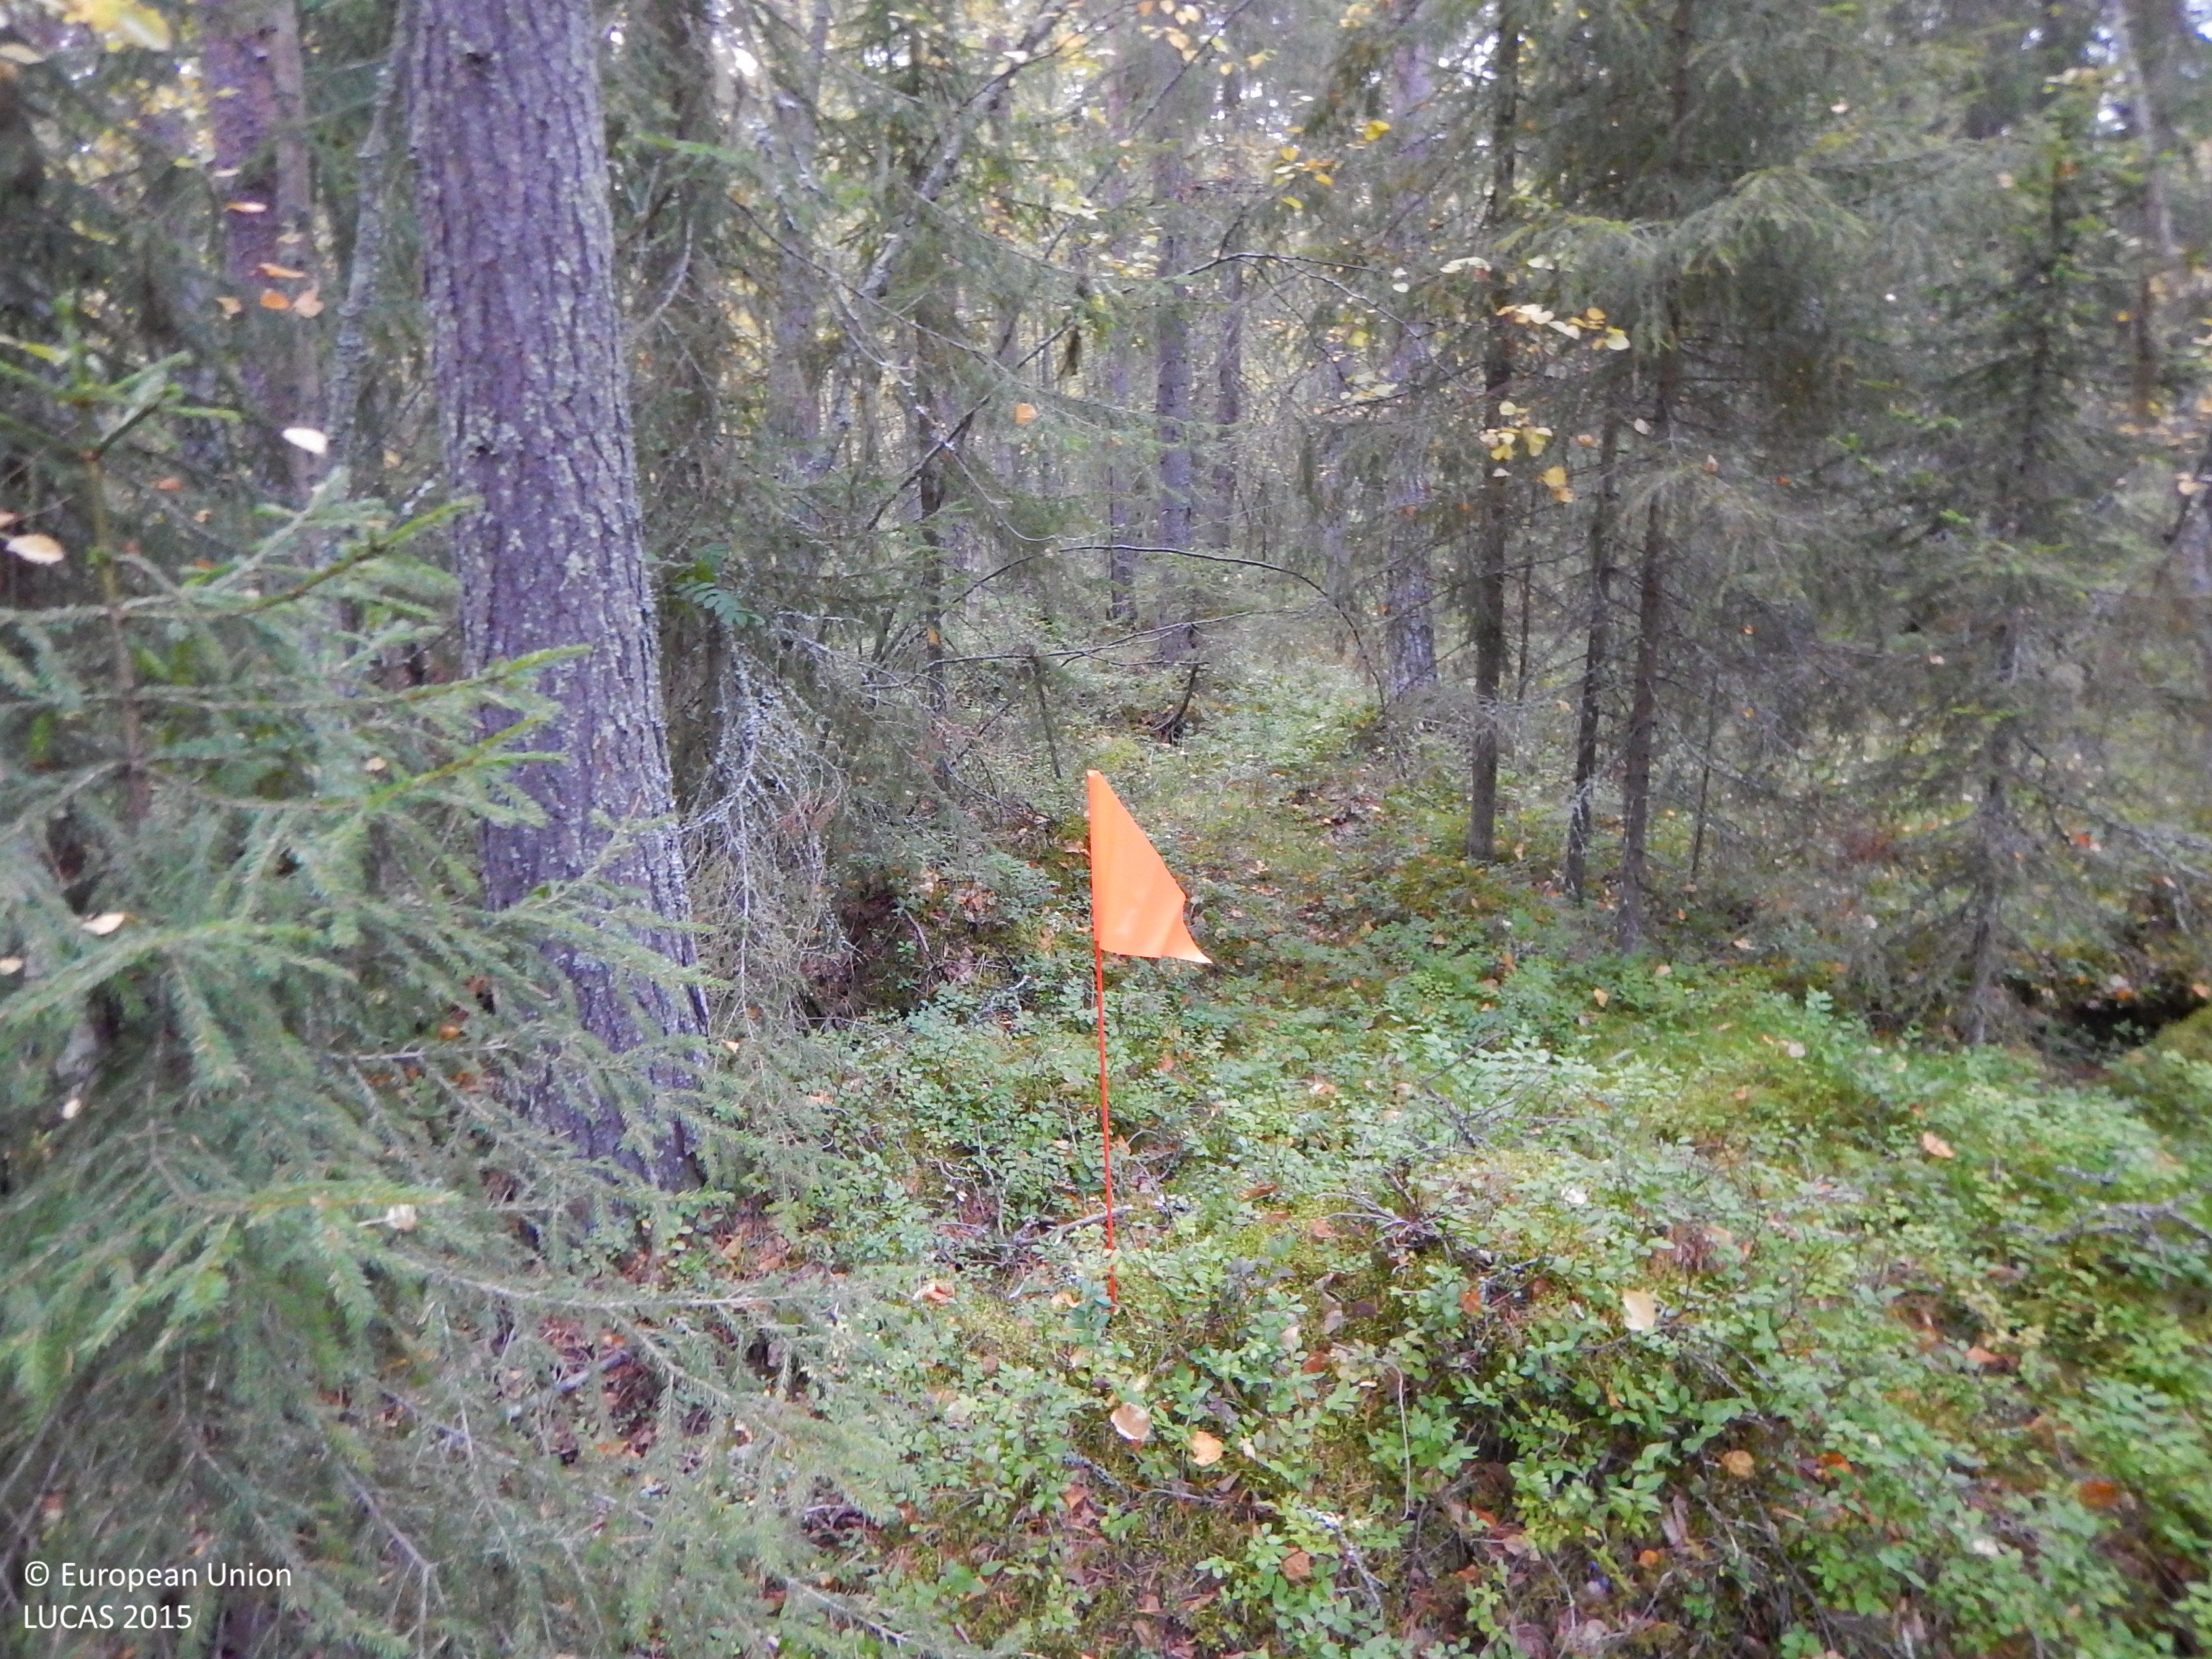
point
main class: Woodland
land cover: Other coniferous woodland
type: boreal forest
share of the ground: 50 - 75 %
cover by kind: coniferous forest trees 45 %, shrubs 25 %, broadleaved forest trees 15 %, lichens and mosses 15 %
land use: Forestry
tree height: > 5 m
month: September
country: SE
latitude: 64.7490
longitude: 20.1201
